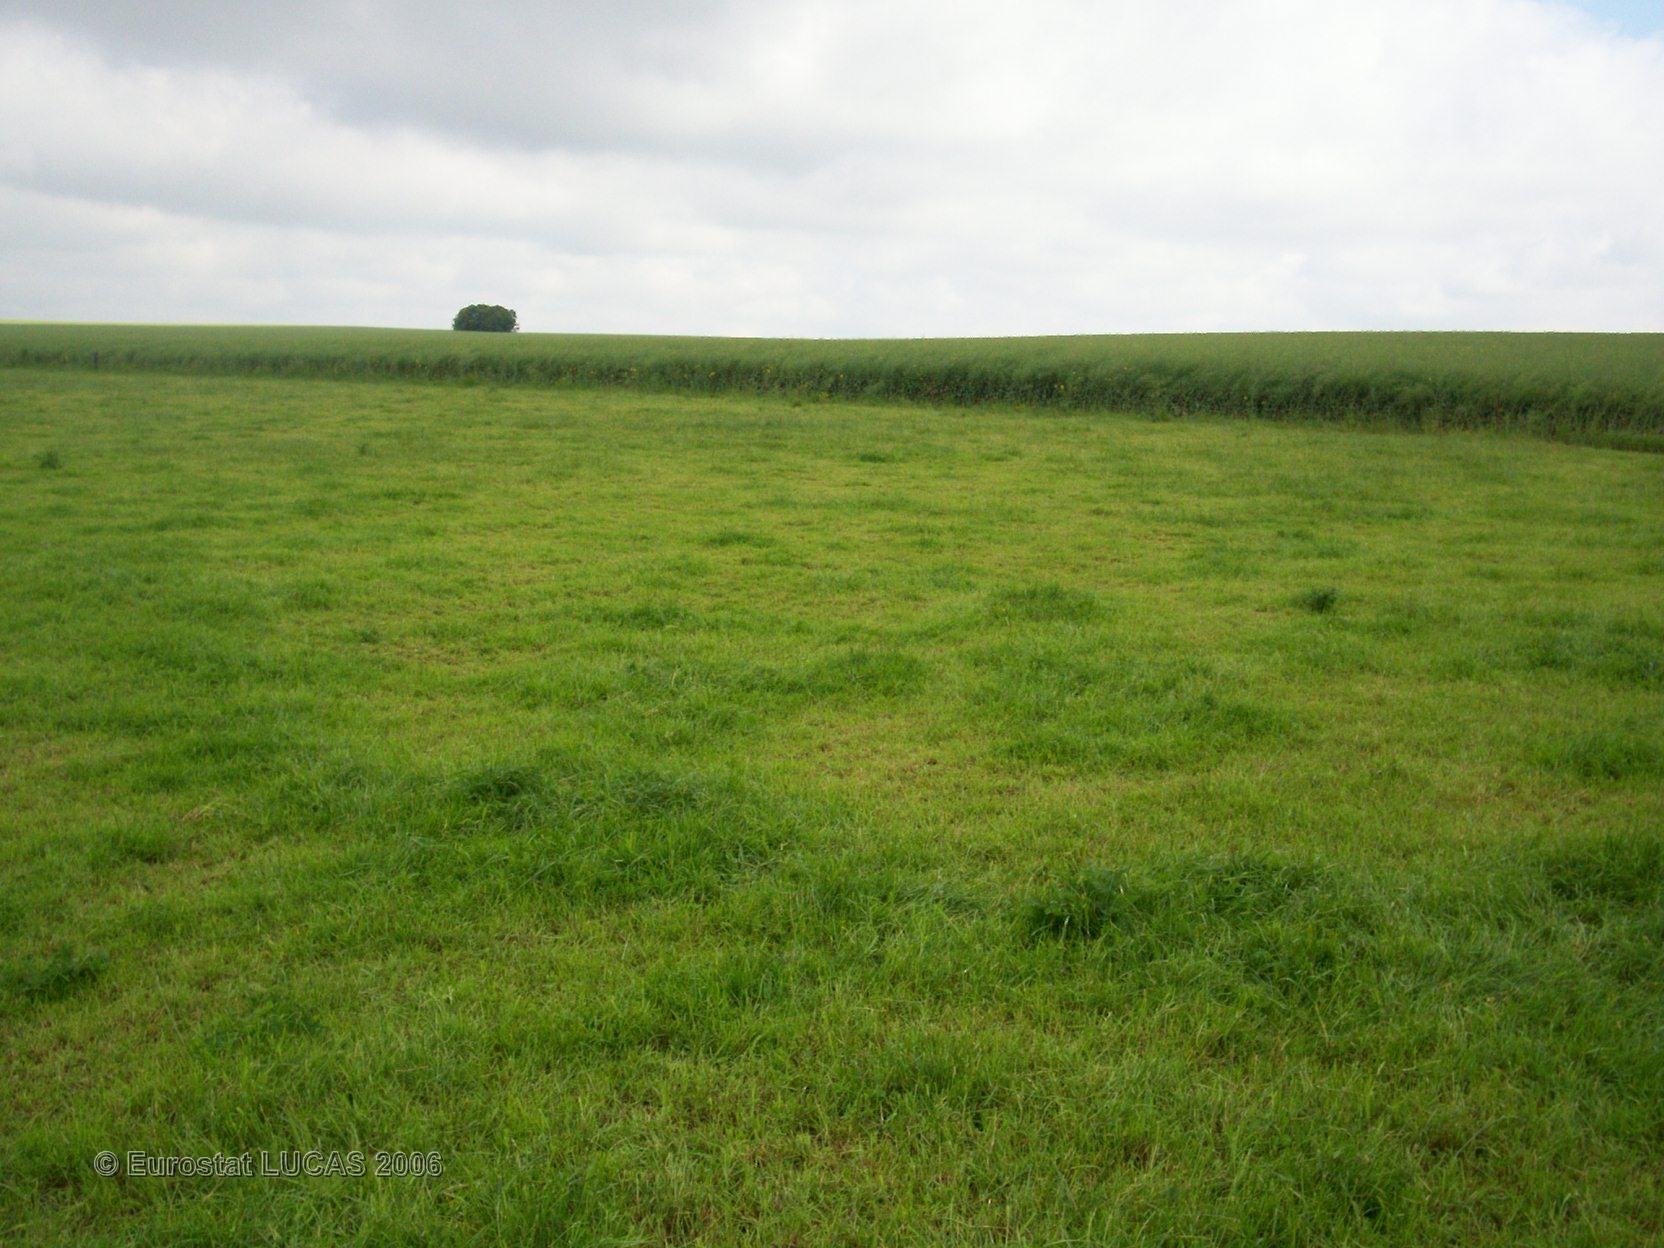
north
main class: Grassland
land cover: Grassland without tree/shrub cover
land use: Agriculture (excluding fallow land and kitchen gardens)
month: June
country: FR
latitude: 48.5530
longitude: 4.4560
